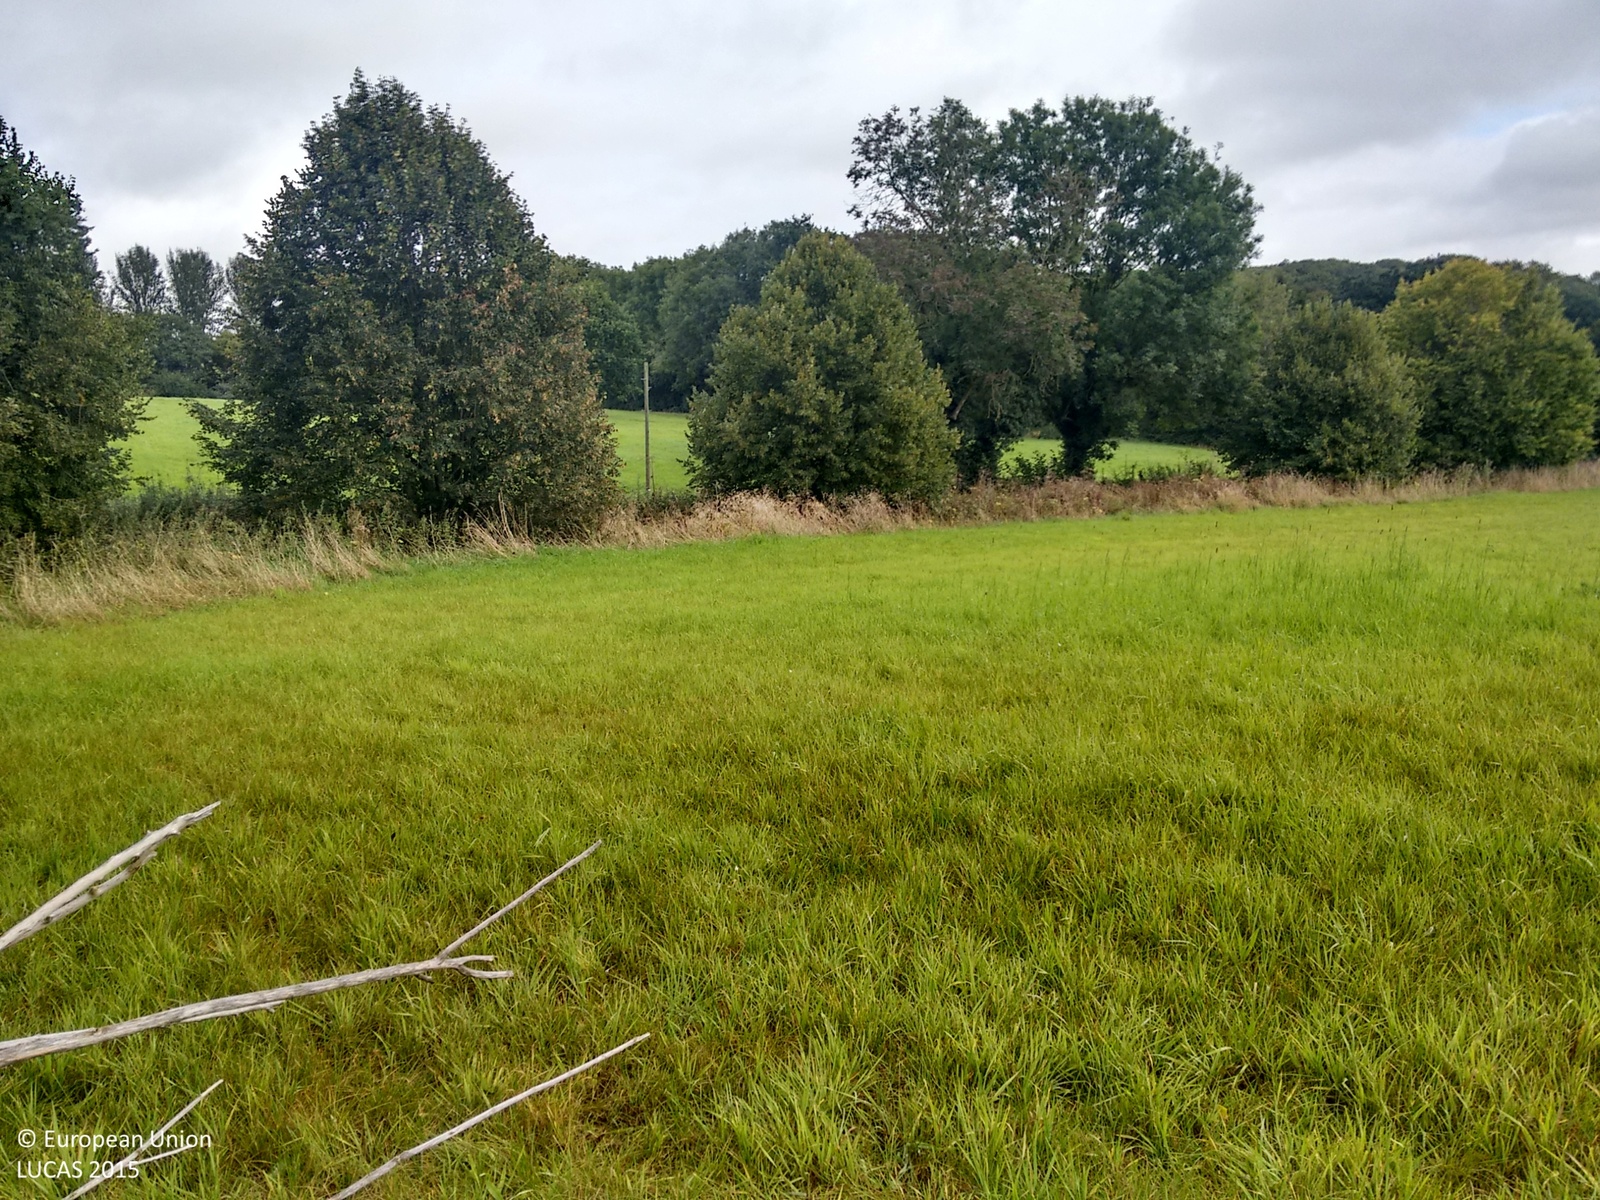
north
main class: Woodland
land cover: Broadleaved woodland
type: mesophytic deciduous forest
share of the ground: > 75 %
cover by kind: broadleaved forest trees 100 %
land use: Semi-natural and natural areas not in use
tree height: > 5 m
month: September
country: GB
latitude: 52.3001
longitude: 1.4015
